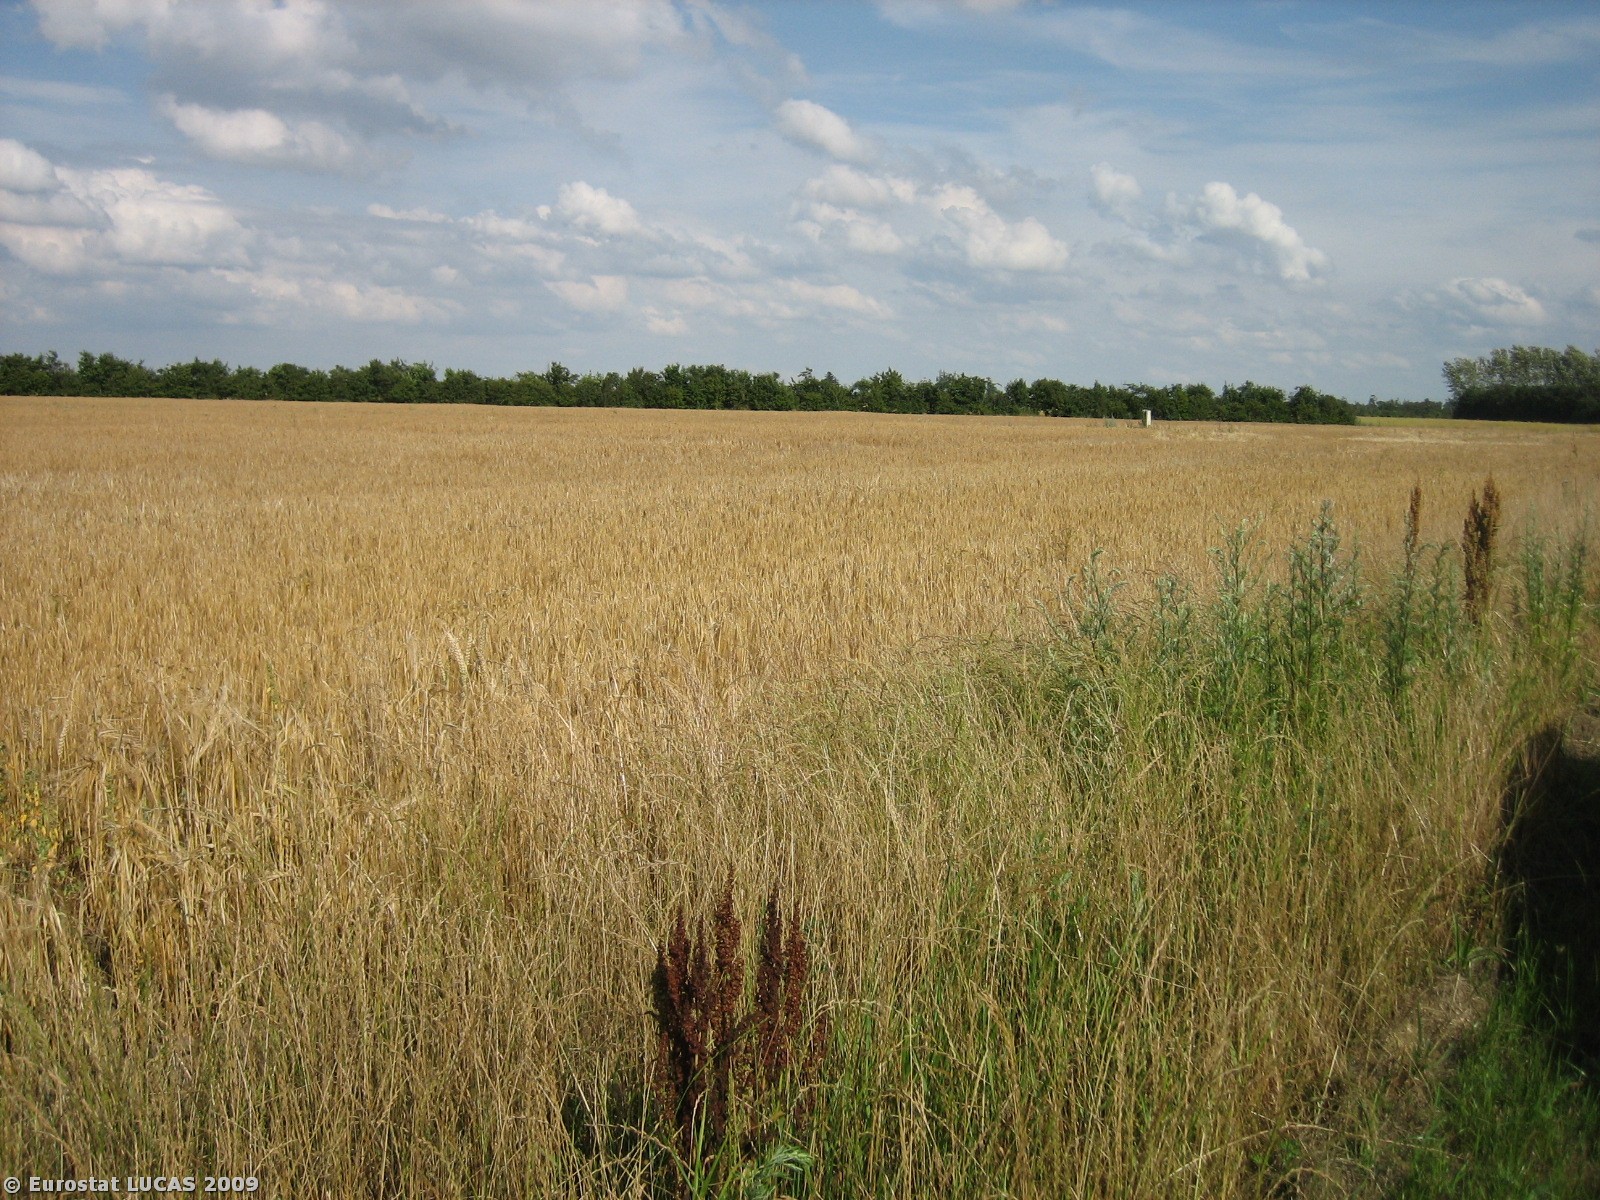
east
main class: Cropland
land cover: Barley
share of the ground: > 75 %
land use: Agriculture (excluding fallow land and kitchen gardens)
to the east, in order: Barley; Broadleaved woodland; Rape and turnip rape
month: July
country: DK
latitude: 55.7693
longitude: 8.8694
